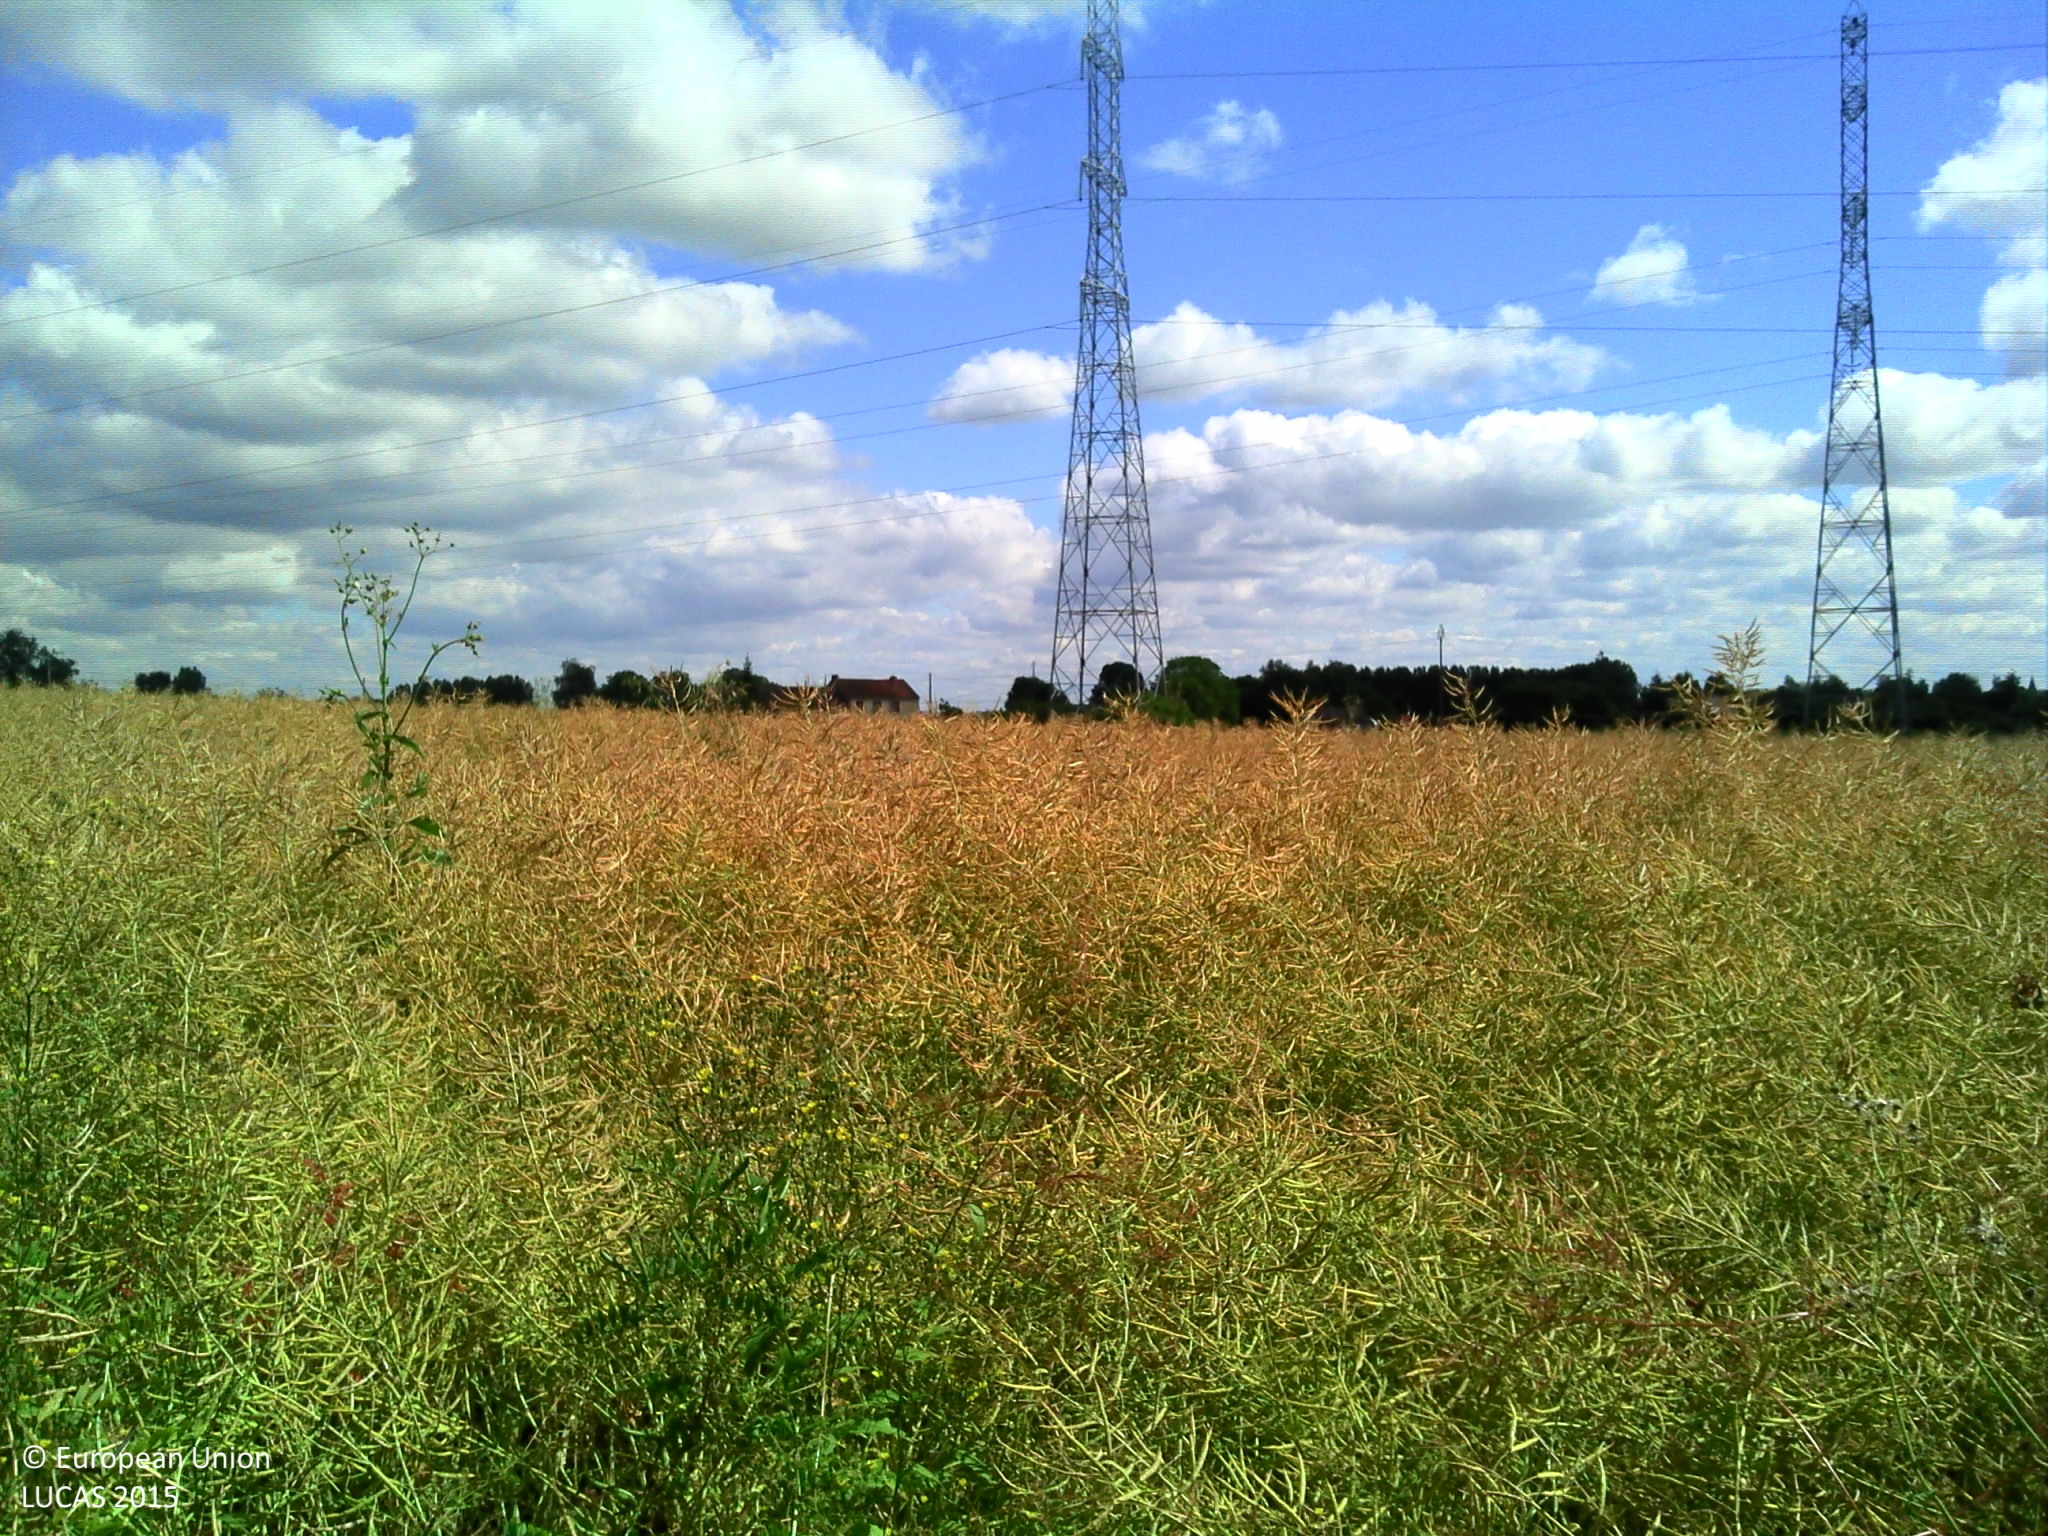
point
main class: Cropland
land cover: Rape and turnip rape
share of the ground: > 75 %
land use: Agriculture (excluding fallow land and kitchen gardens)
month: June
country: FR
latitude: 47.8813
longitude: 0.2534
